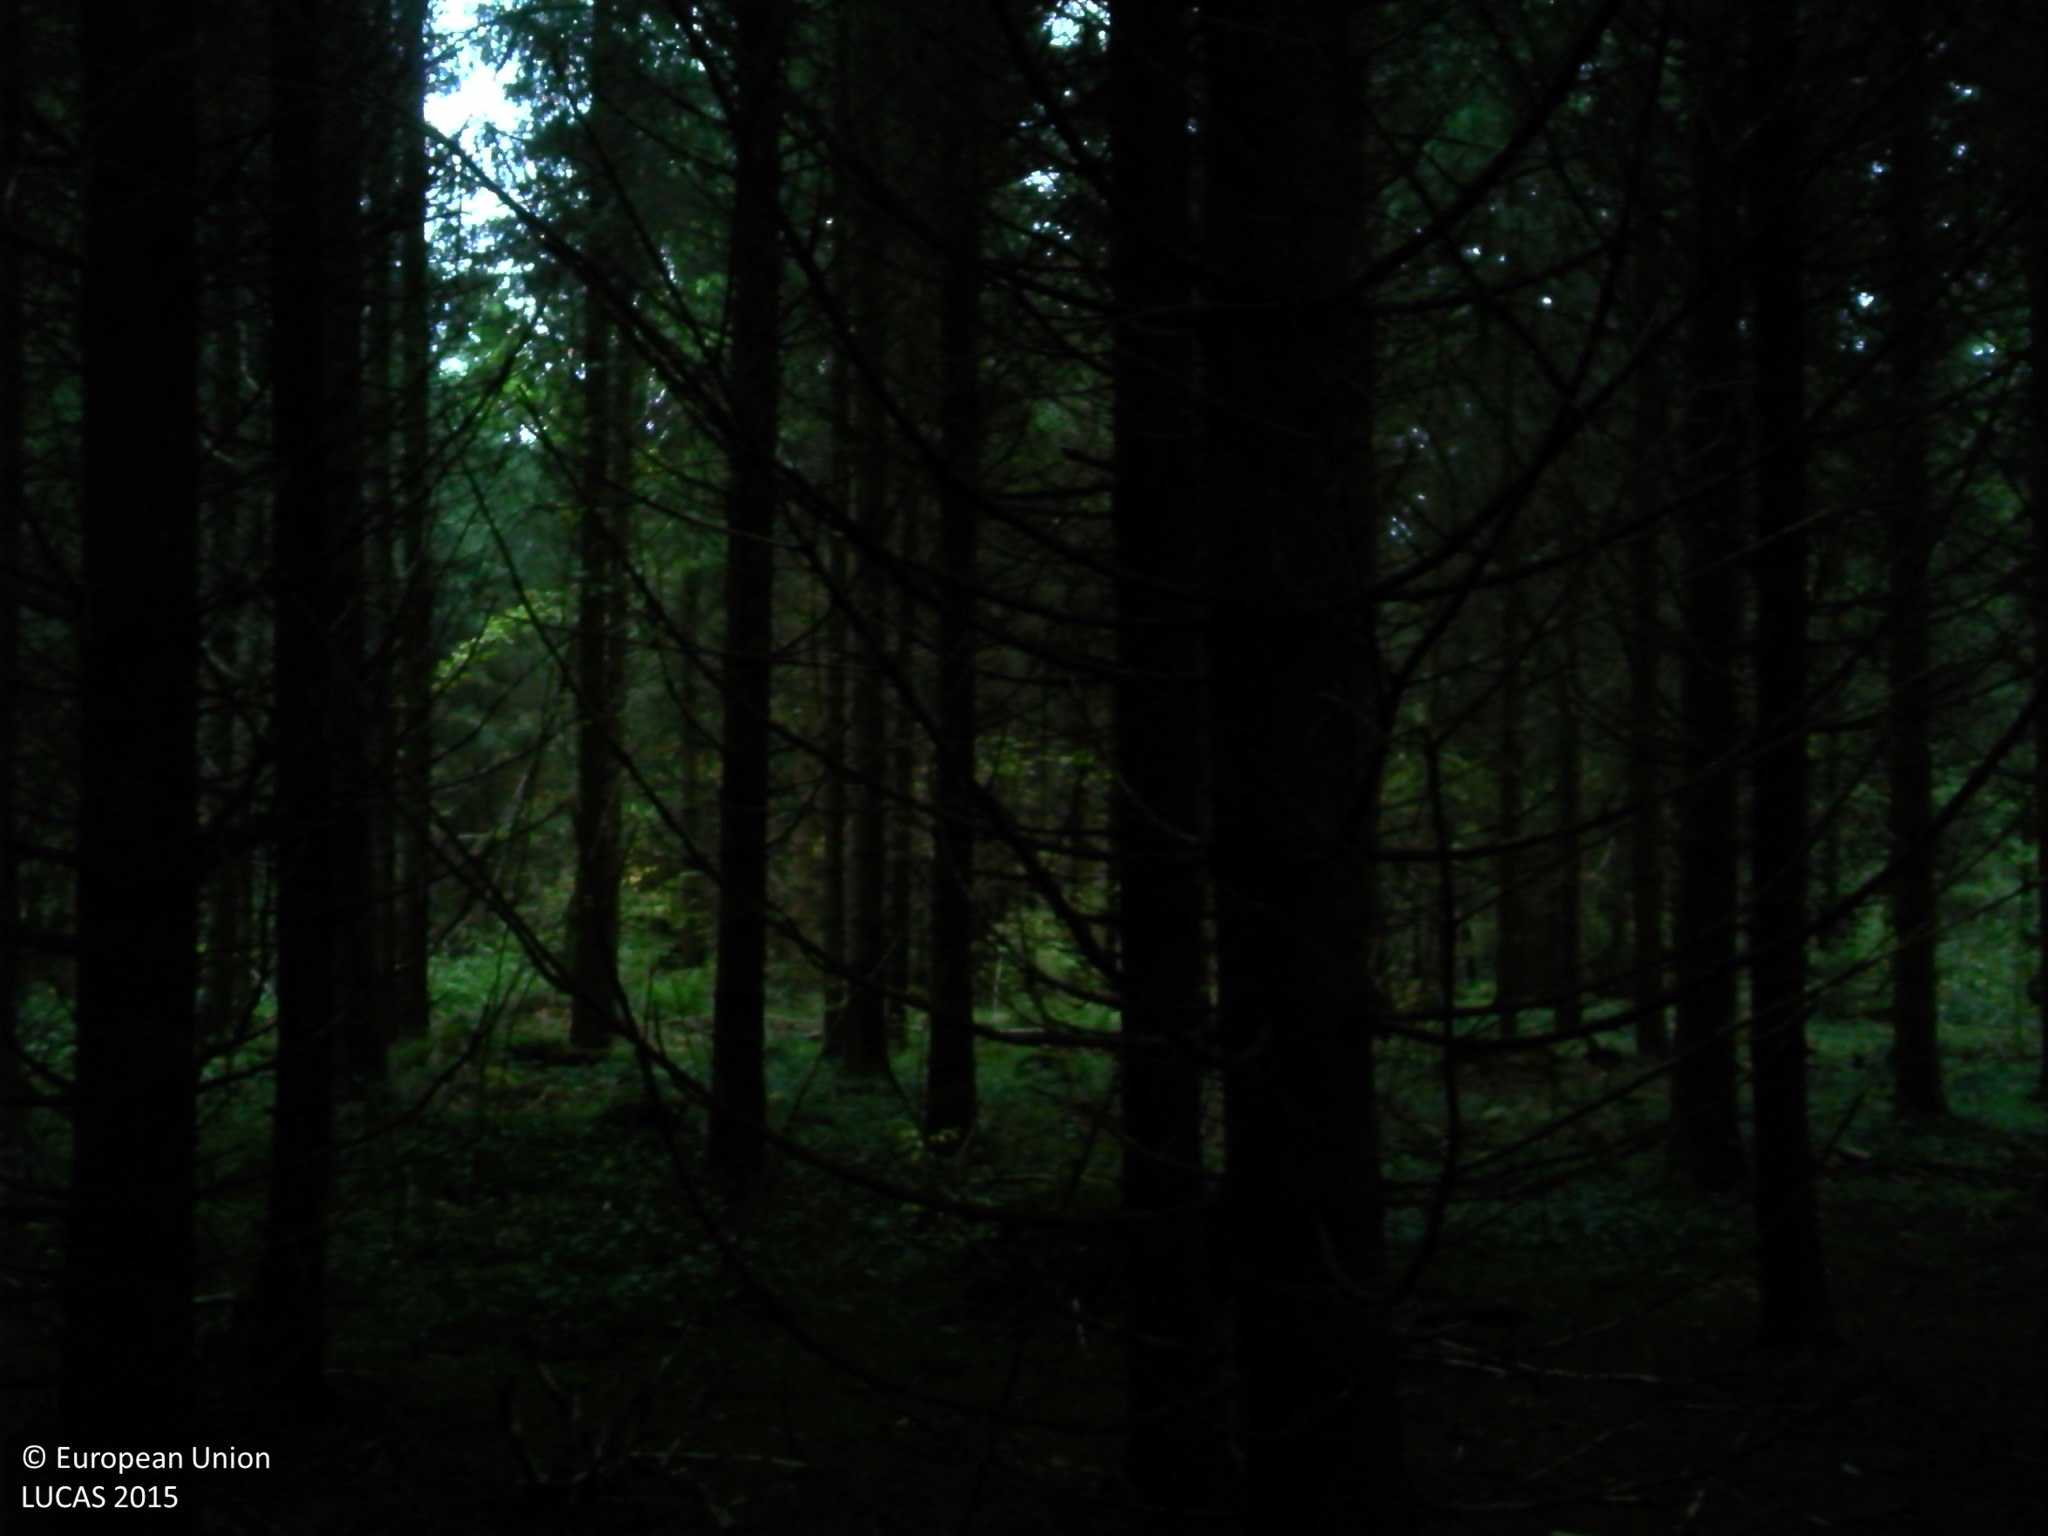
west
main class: Woodland
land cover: Spruce dominated coniferous woodland
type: alpine coniferous forest
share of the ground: > 75 %
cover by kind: coniferous forest trees 100 %
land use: Forestry
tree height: > 5 m
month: October
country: FR
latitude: 46.9463
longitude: 6.0740
